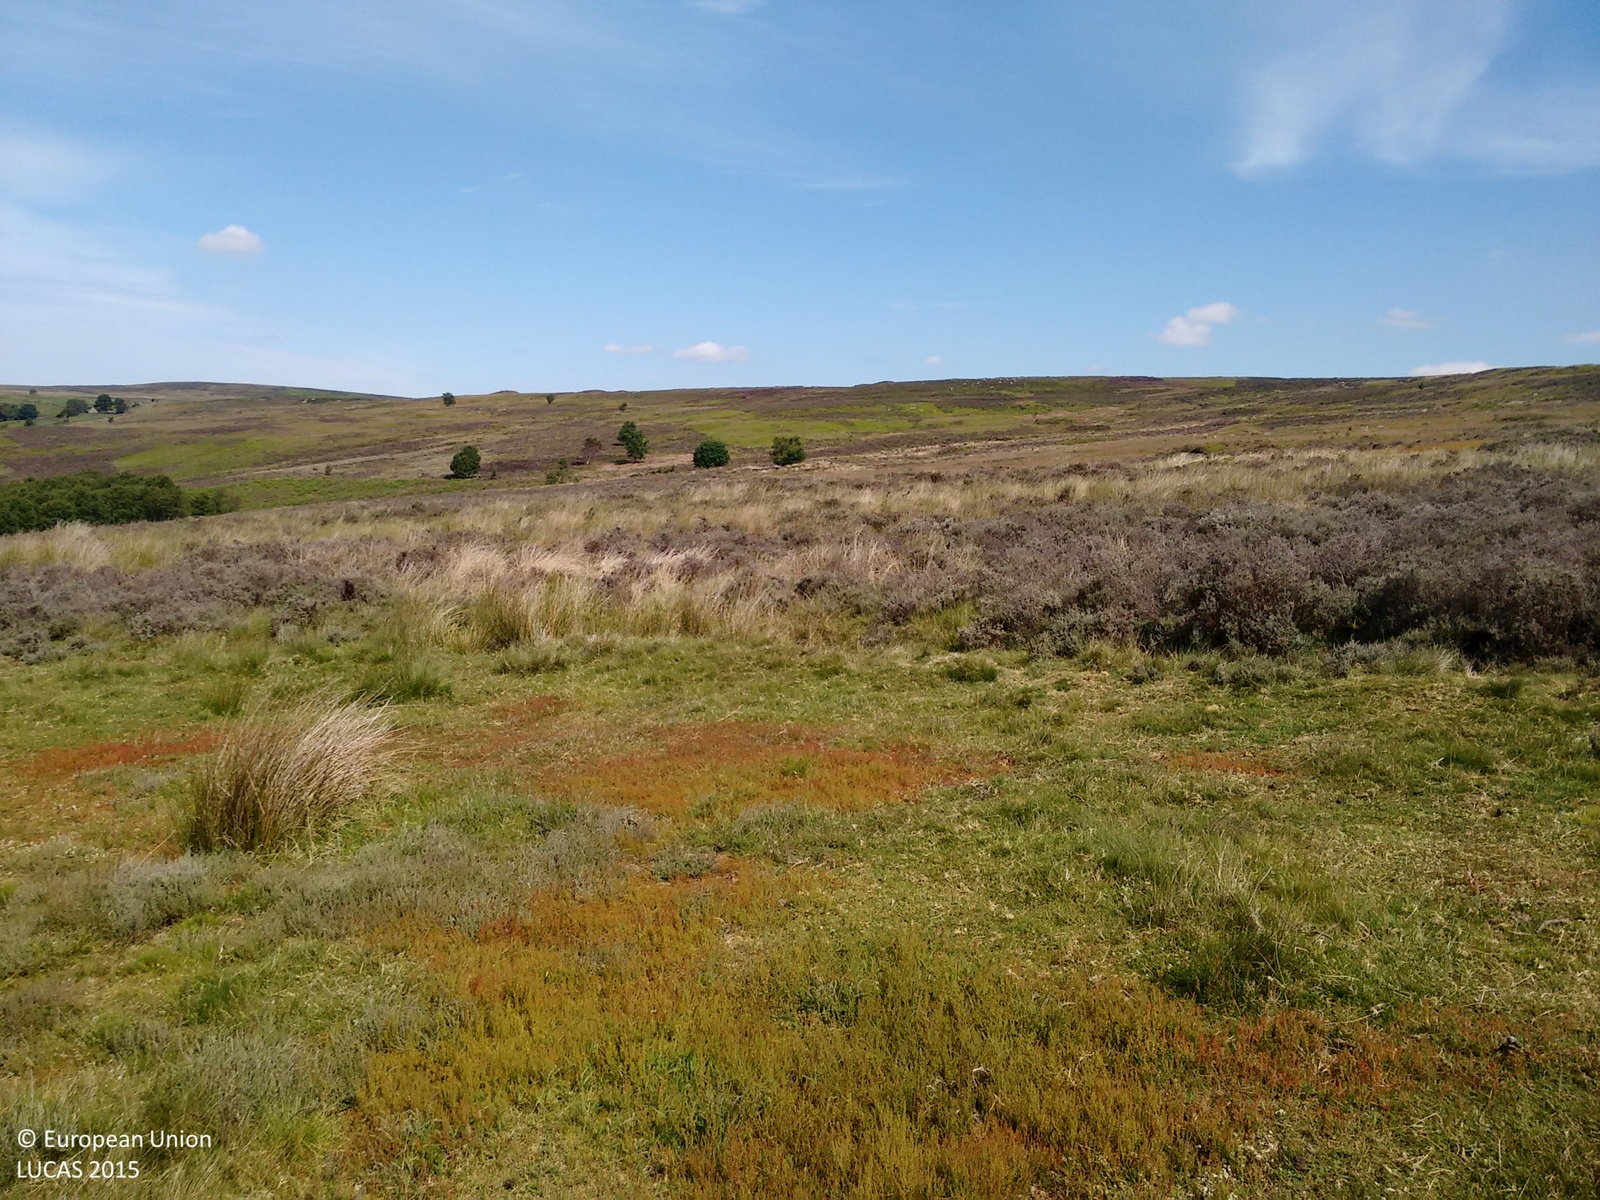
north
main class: Shrubland
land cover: Shrubland without tree cover
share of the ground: > 75 %
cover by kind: shrubs 60 %, herbaceous plants 40 %
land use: Agriculture (excluding fallow land and kitchen gardens)
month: July
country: GB
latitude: 54.4703
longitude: -0.8878
